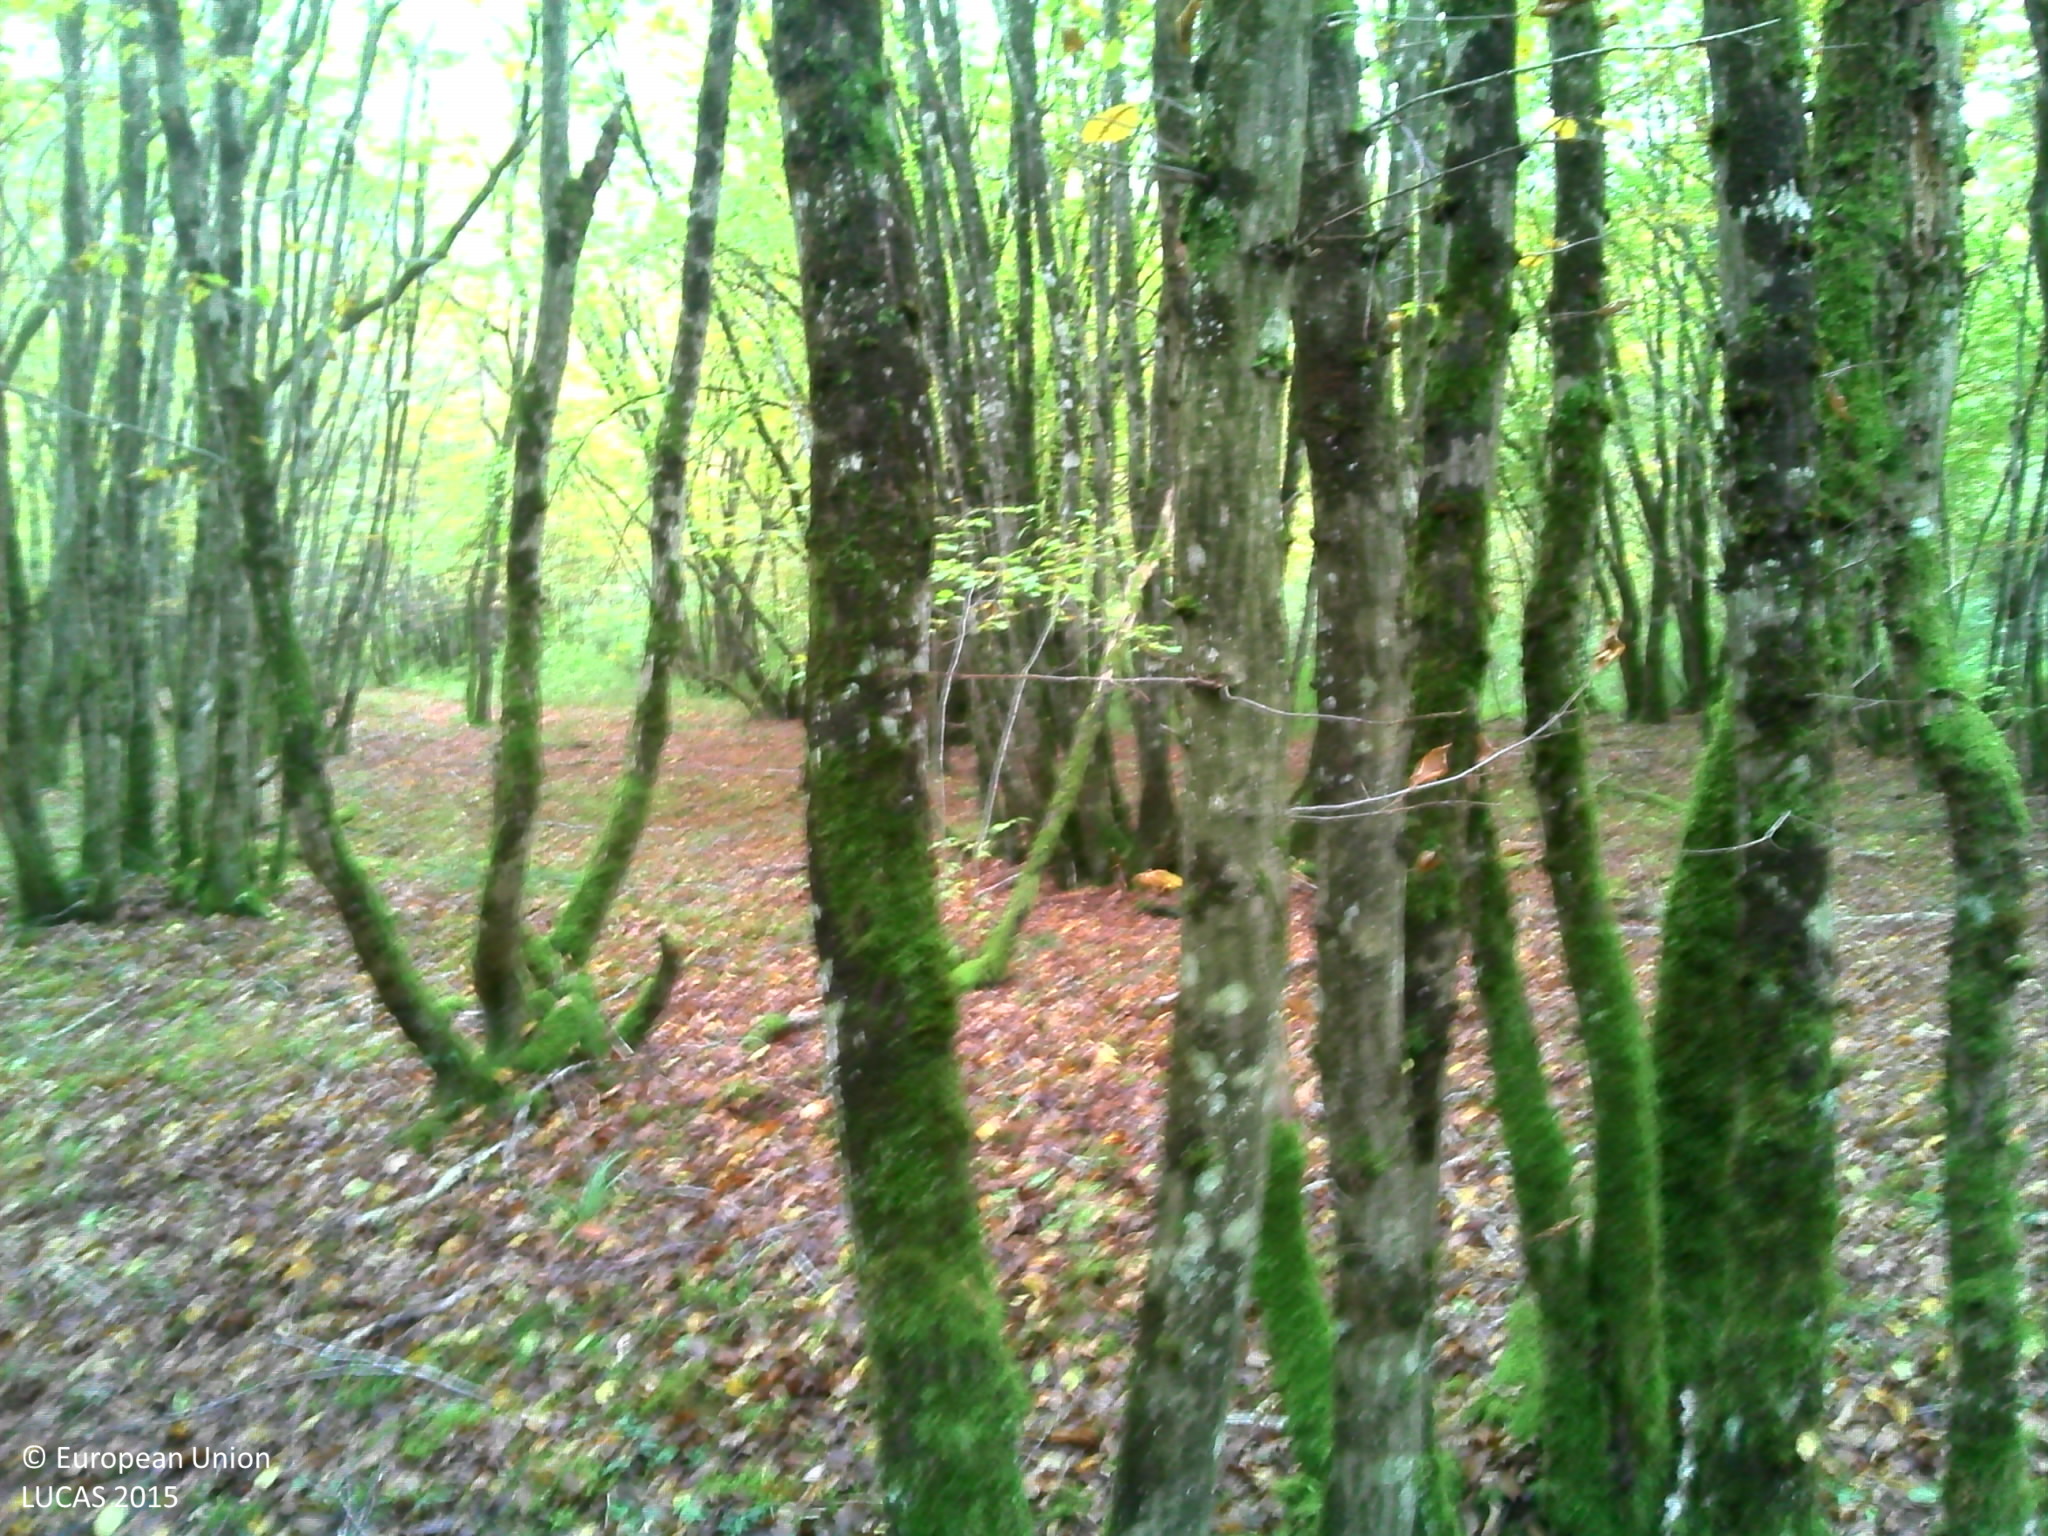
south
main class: Woodland
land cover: Broadleaved woodland
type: mesophytic deciduous forest
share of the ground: > 75 %
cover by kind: broadleaved forest trees 90 %, herbaceous plants 10 %
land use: Forestry
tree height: > 5 m
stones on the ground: < 10 %
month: October
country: FR
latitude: 47.5328
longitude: 4.9921
